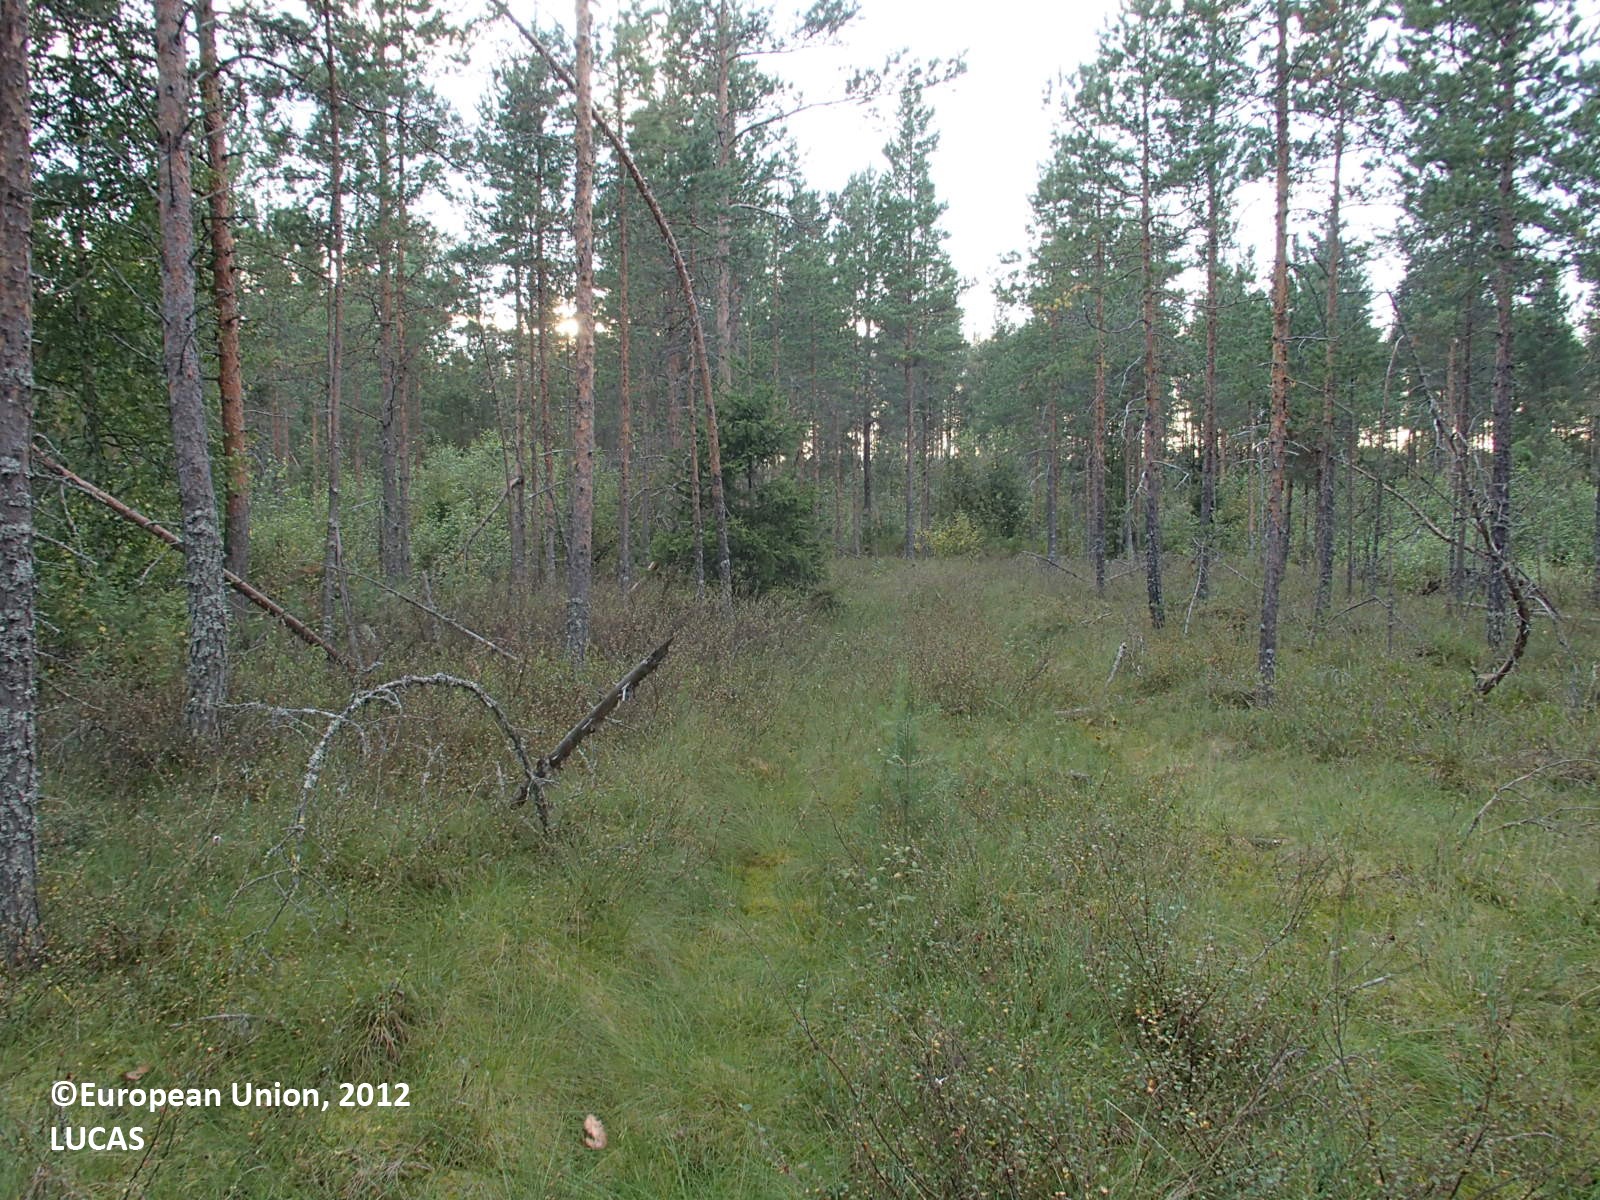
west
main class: Woodland
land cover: Pine dominated coniferous woodland
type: boreal forest
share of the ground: 25 - 50 %
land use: Forestry
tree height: > 5 m
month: August
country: FI
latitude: 63.9278
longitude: 25.6604
